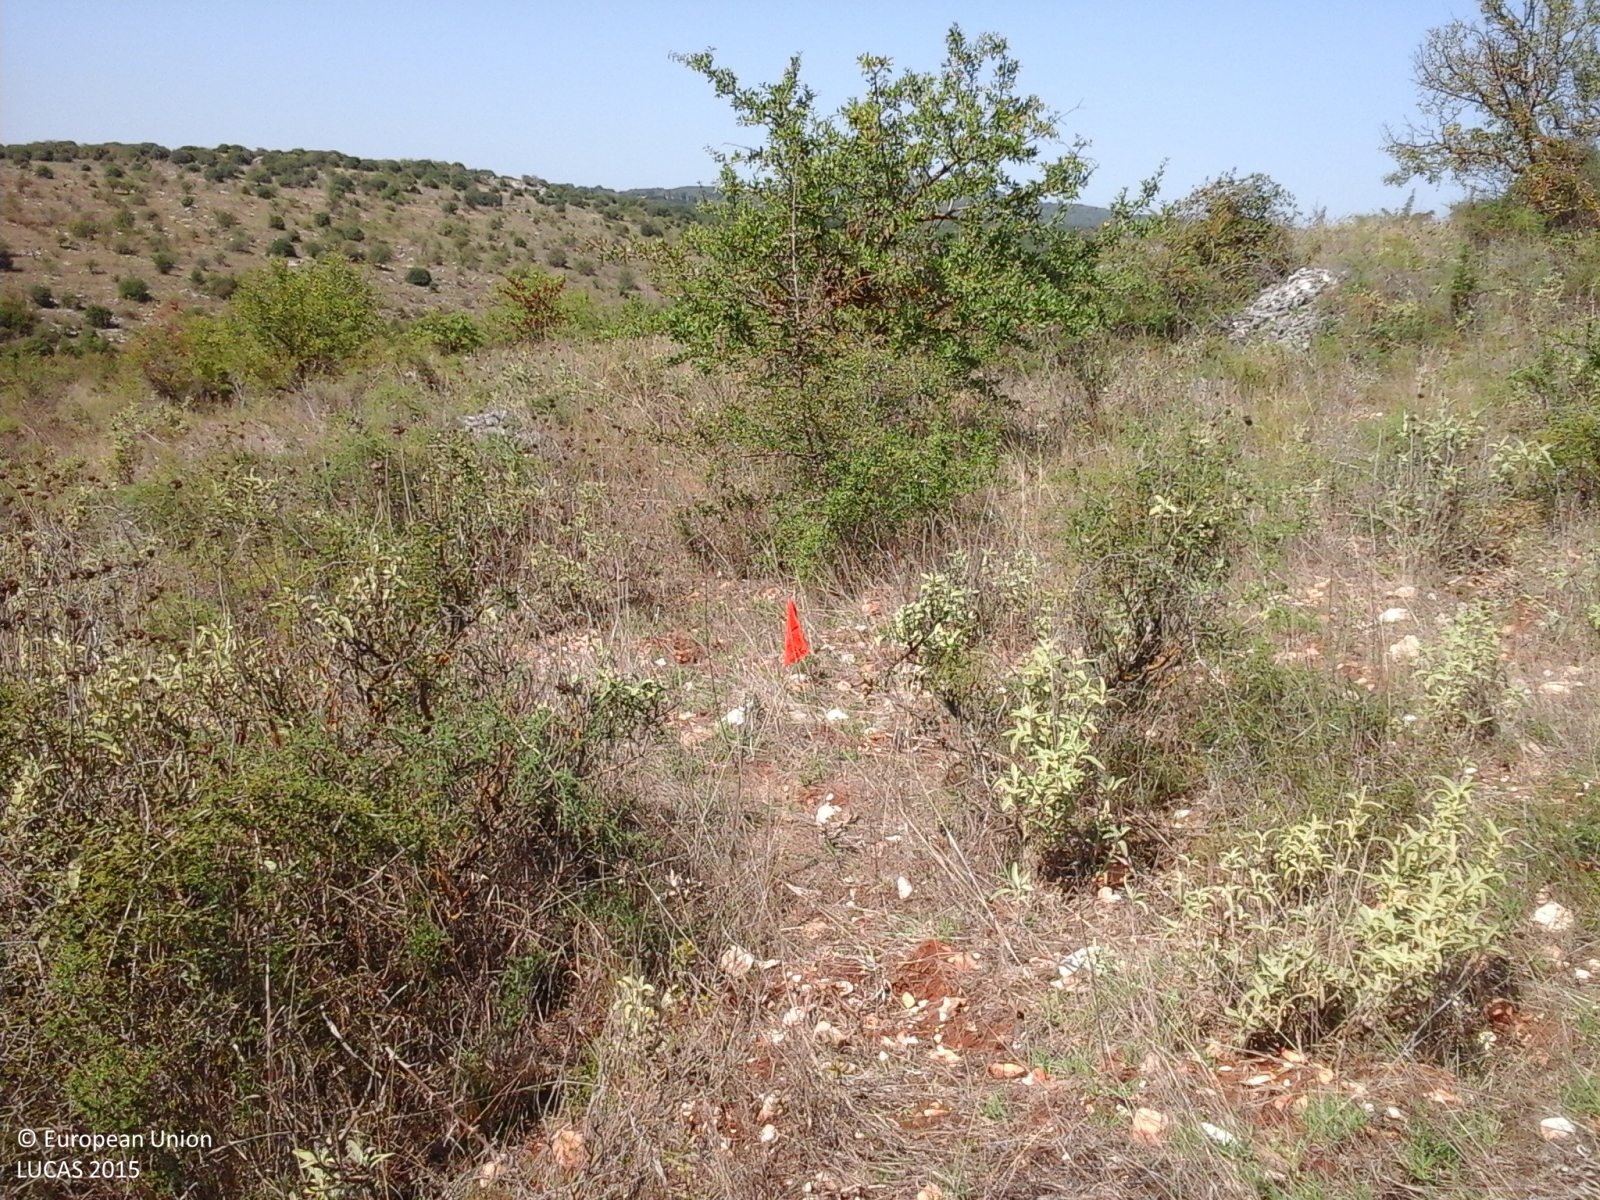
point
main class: Grassland
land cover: Grassland with sparse tree/shrub cover
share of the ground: > 75 %
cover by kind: herbaceous plants 70 %, unconsolidated bare surface 15 %, shrubs 10 %, broadleaved forest trees 5 %
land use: Semi-natural and natural areas not in use
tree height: < 5 m
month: September
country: GR
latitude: 39.7196
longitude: 20.6755
